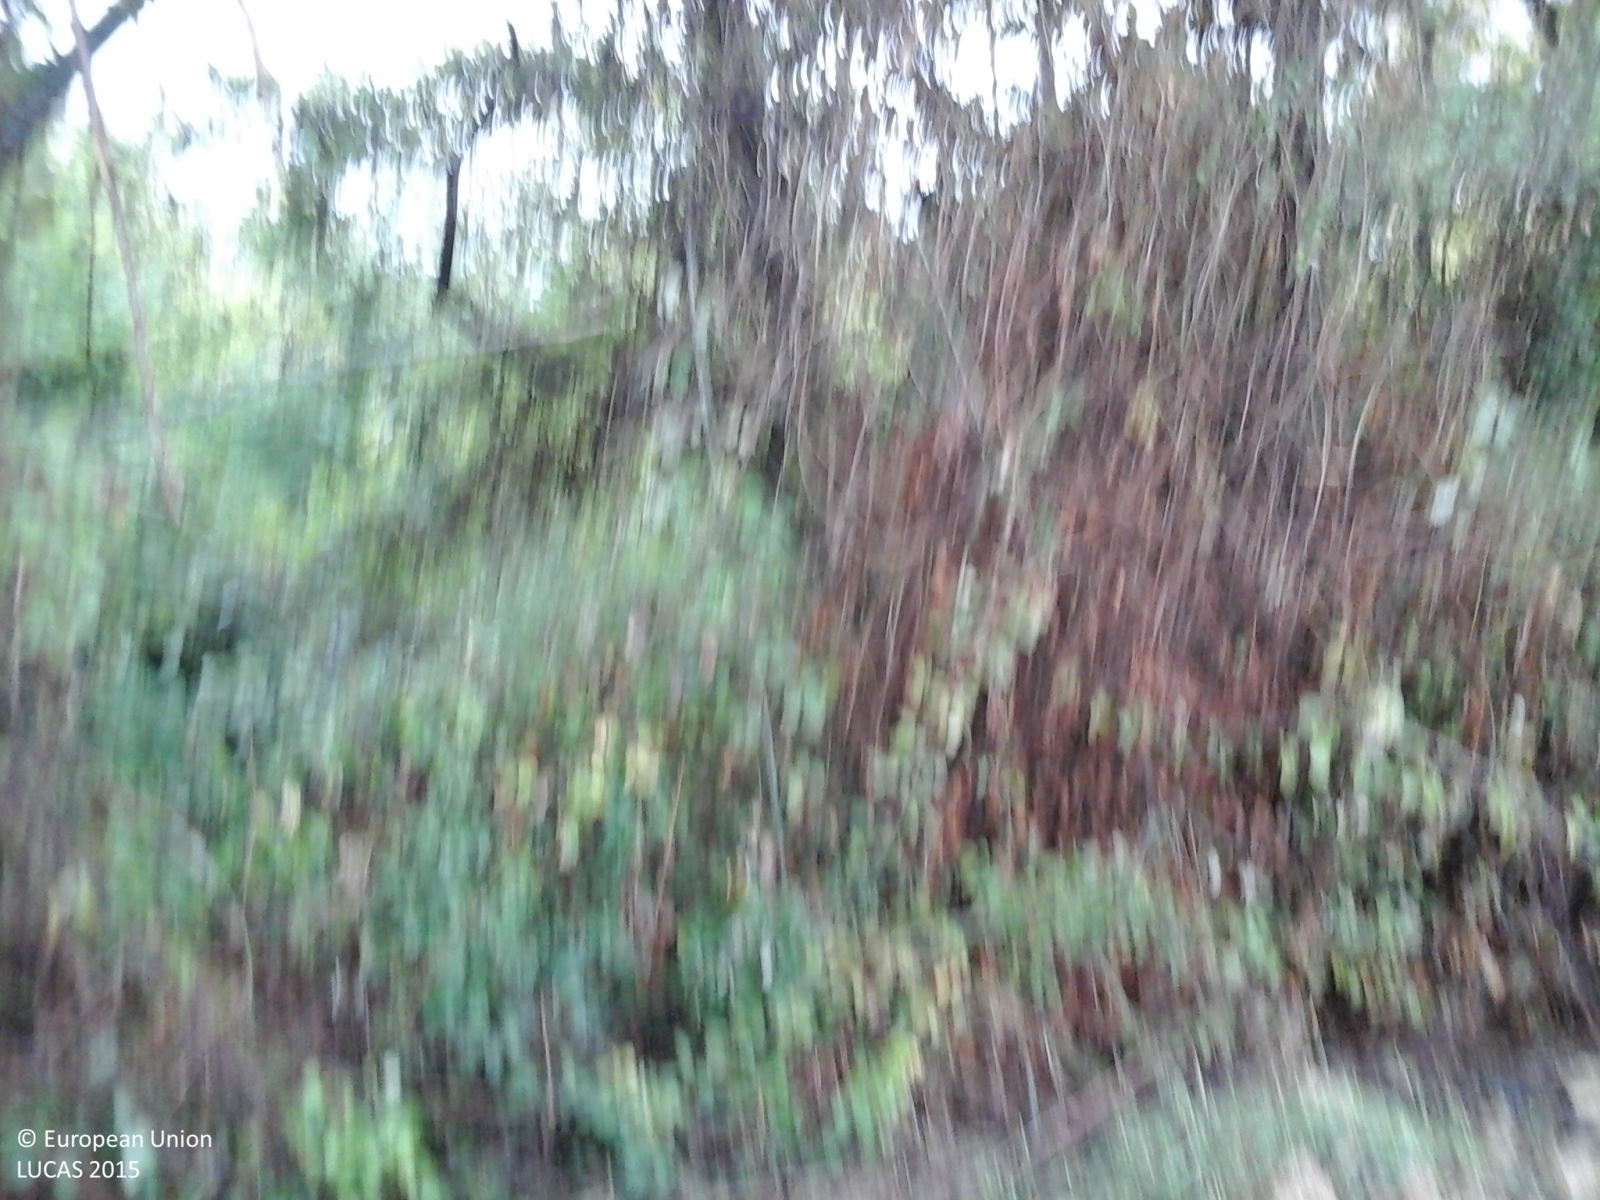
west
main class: Cropland
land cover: Durum wheat
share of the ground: < 10 %
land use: Agriculture (excluding fallow land and kitchen gardens)
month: October
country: IT
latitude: 43.7060
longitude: 13.1818
